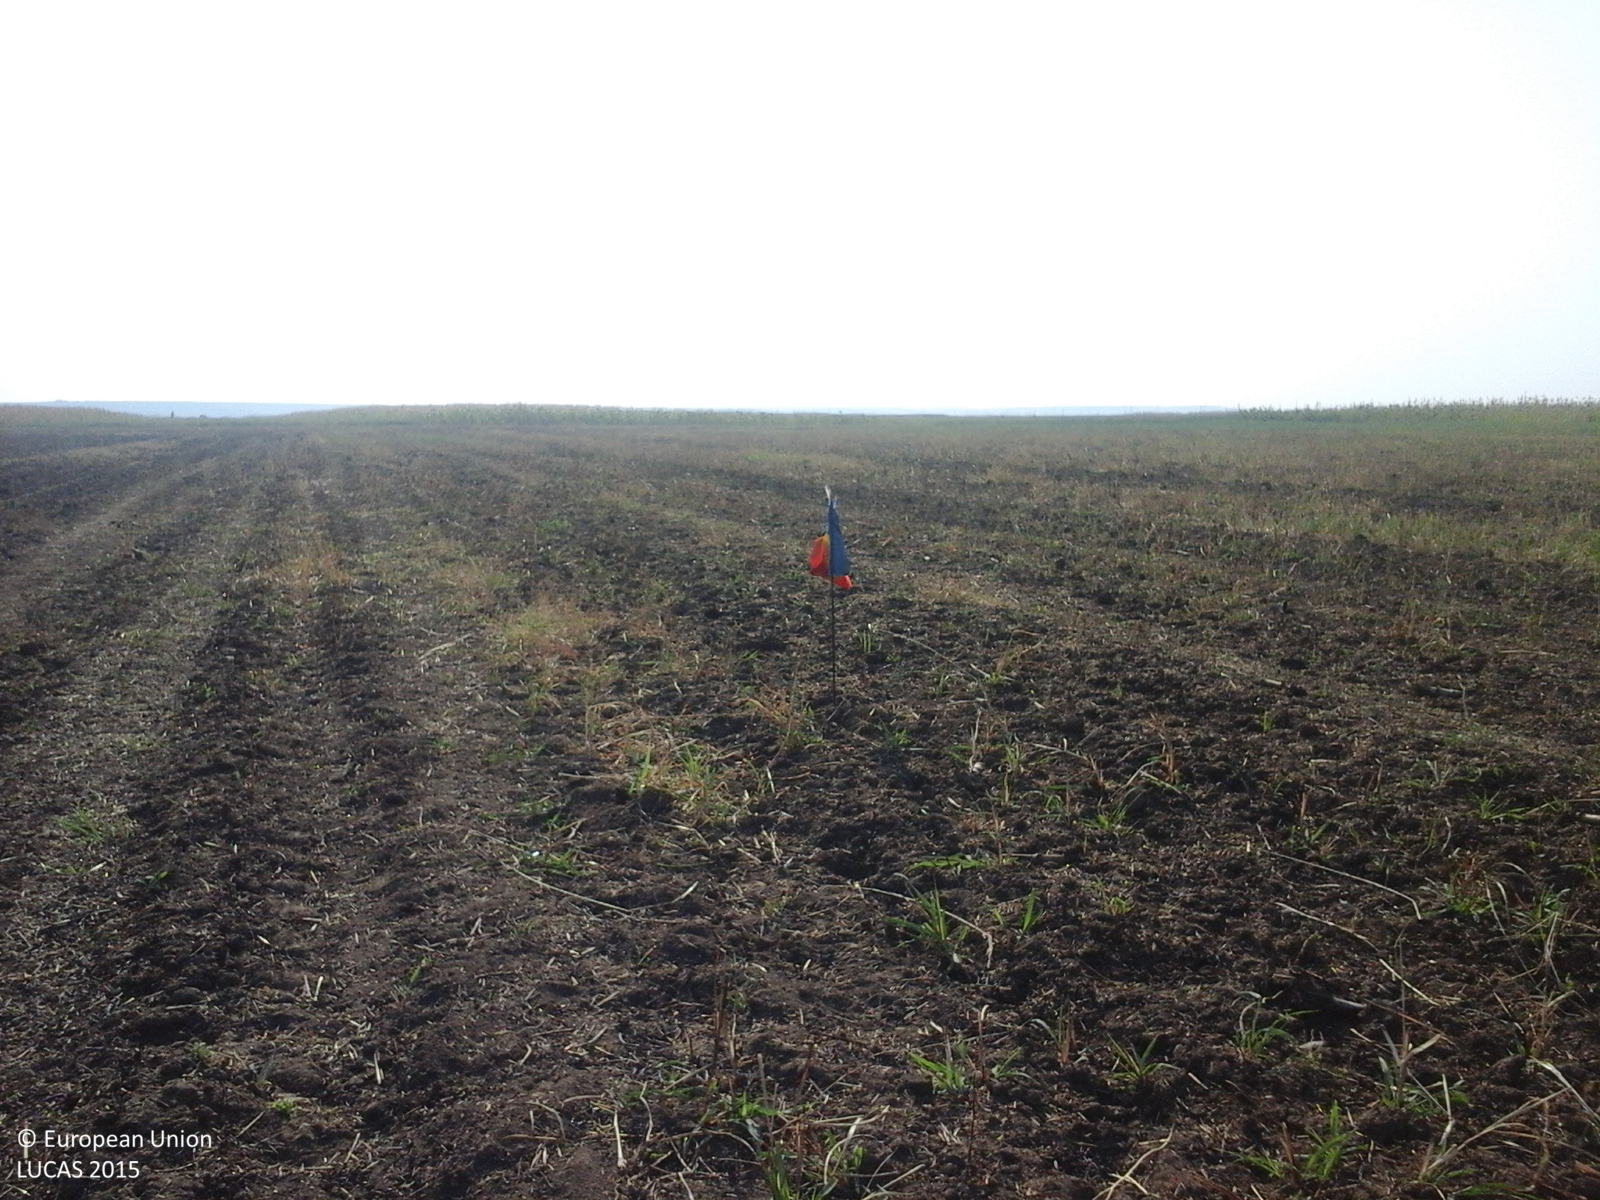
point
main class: Cropland
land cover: Common wheat
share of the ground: < 10 %
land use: Agriculture (excluding fallow land and kitchen gardens)
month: August
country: RO
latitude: 44.1578
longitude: 22.9335
